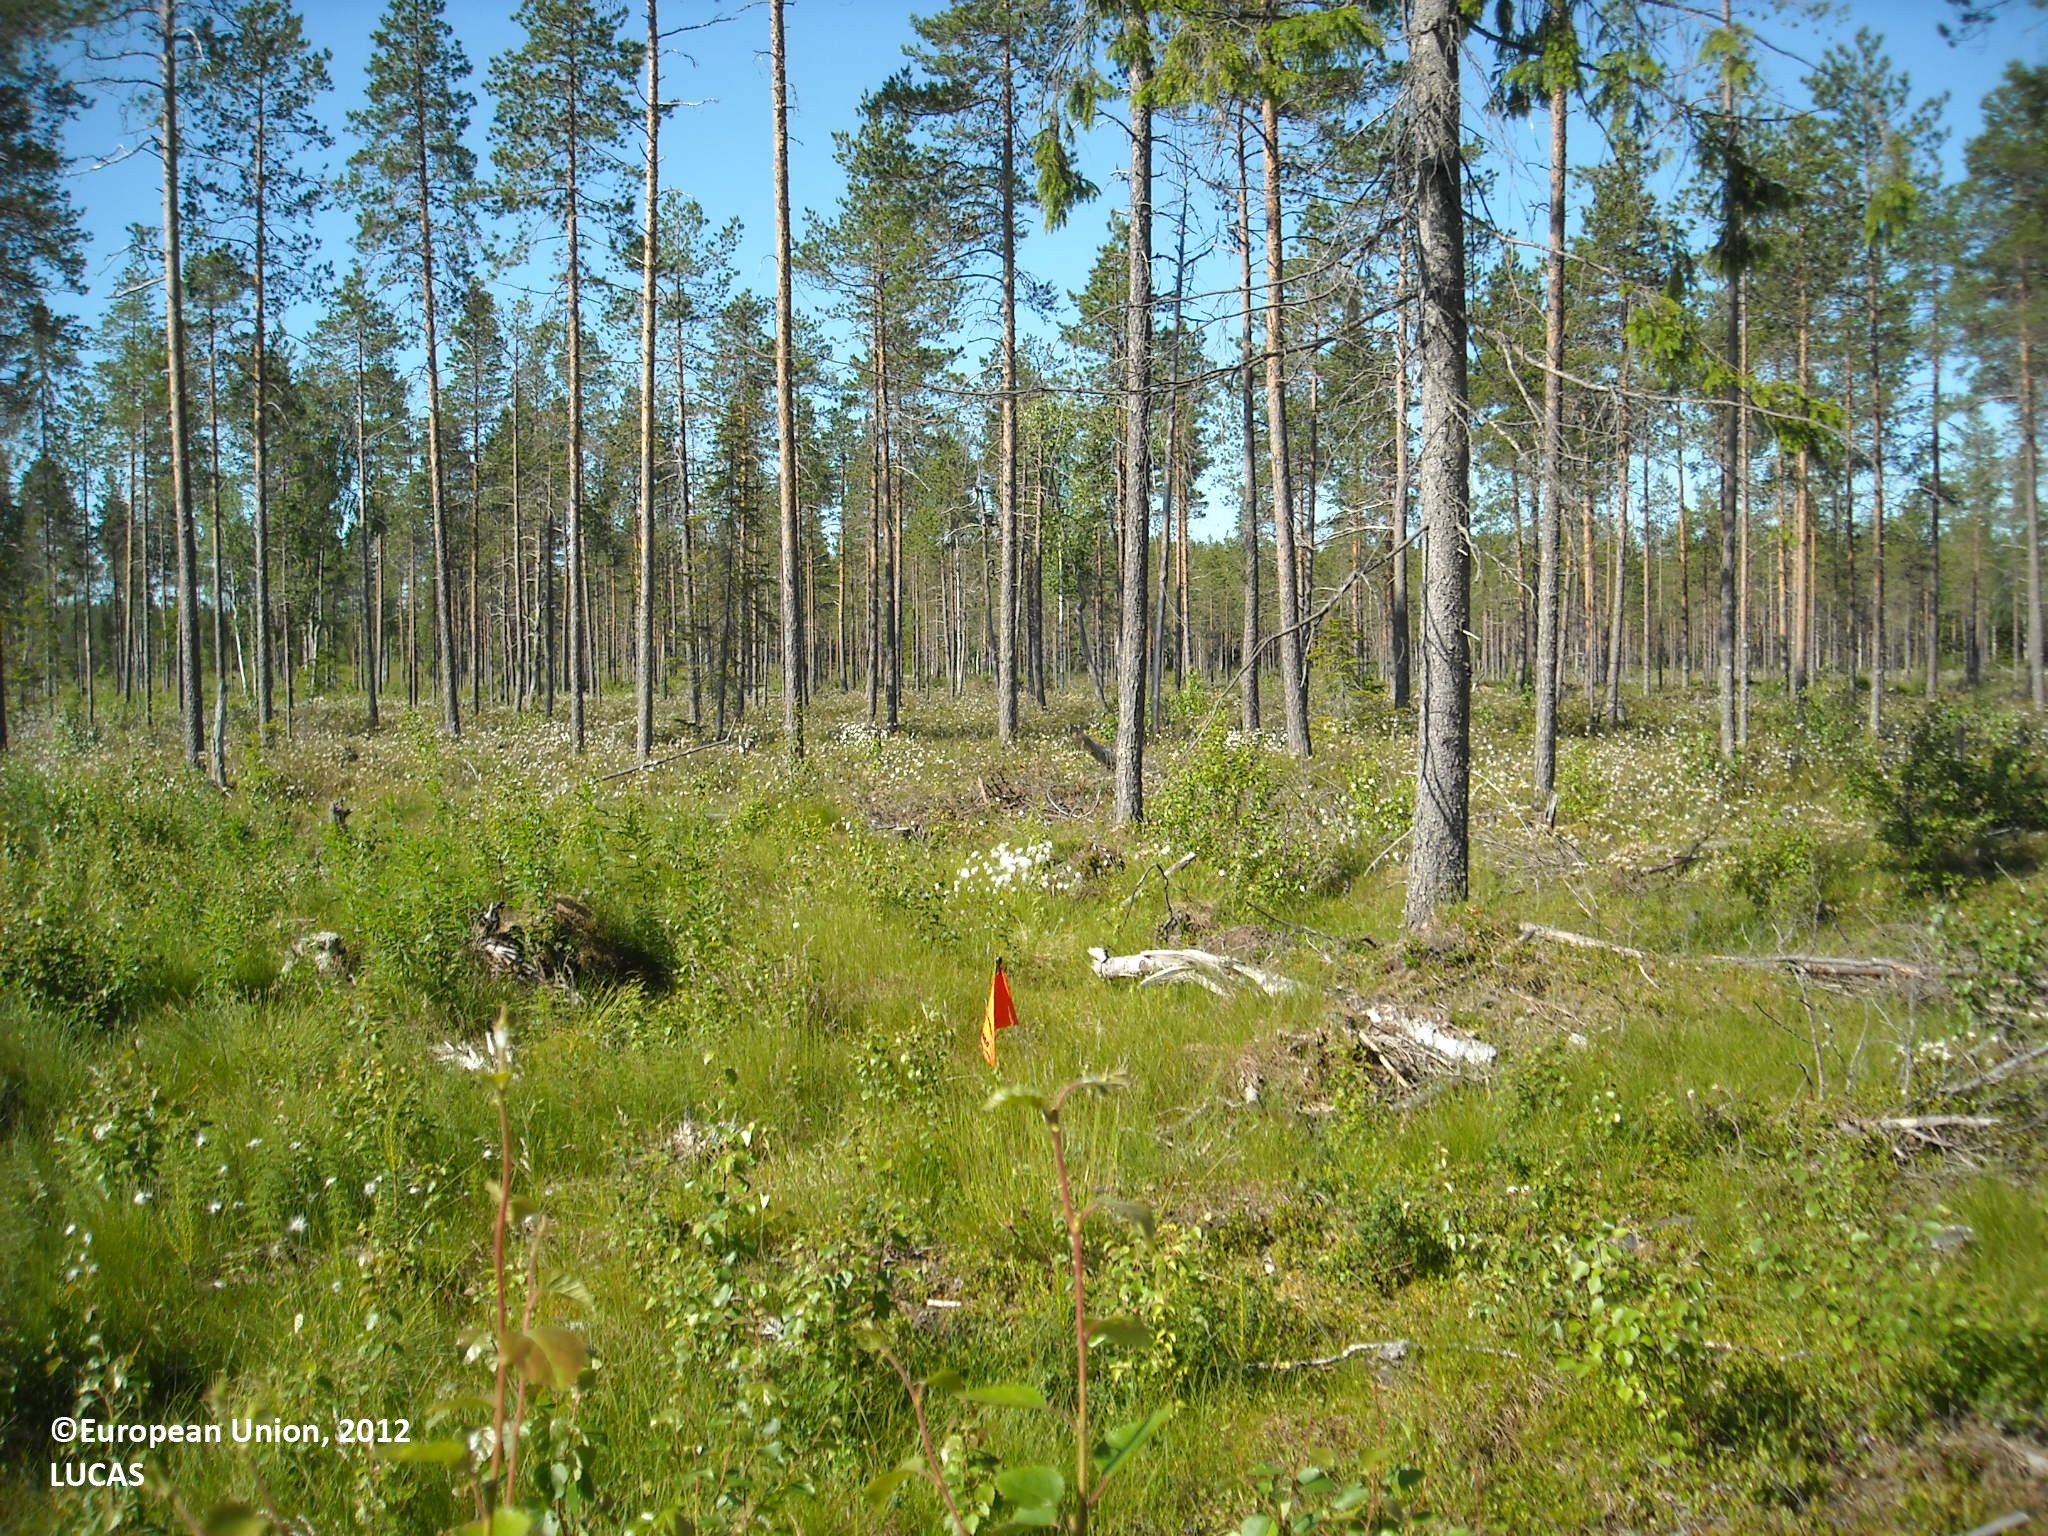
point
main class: Woodland
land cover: Pine dominated coniferous woodland
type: boreal forest
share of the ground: 25 - 50 %
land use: Forestry
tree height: > 5 m
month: July
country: FI
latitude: 64.9215
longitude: 27.4971
